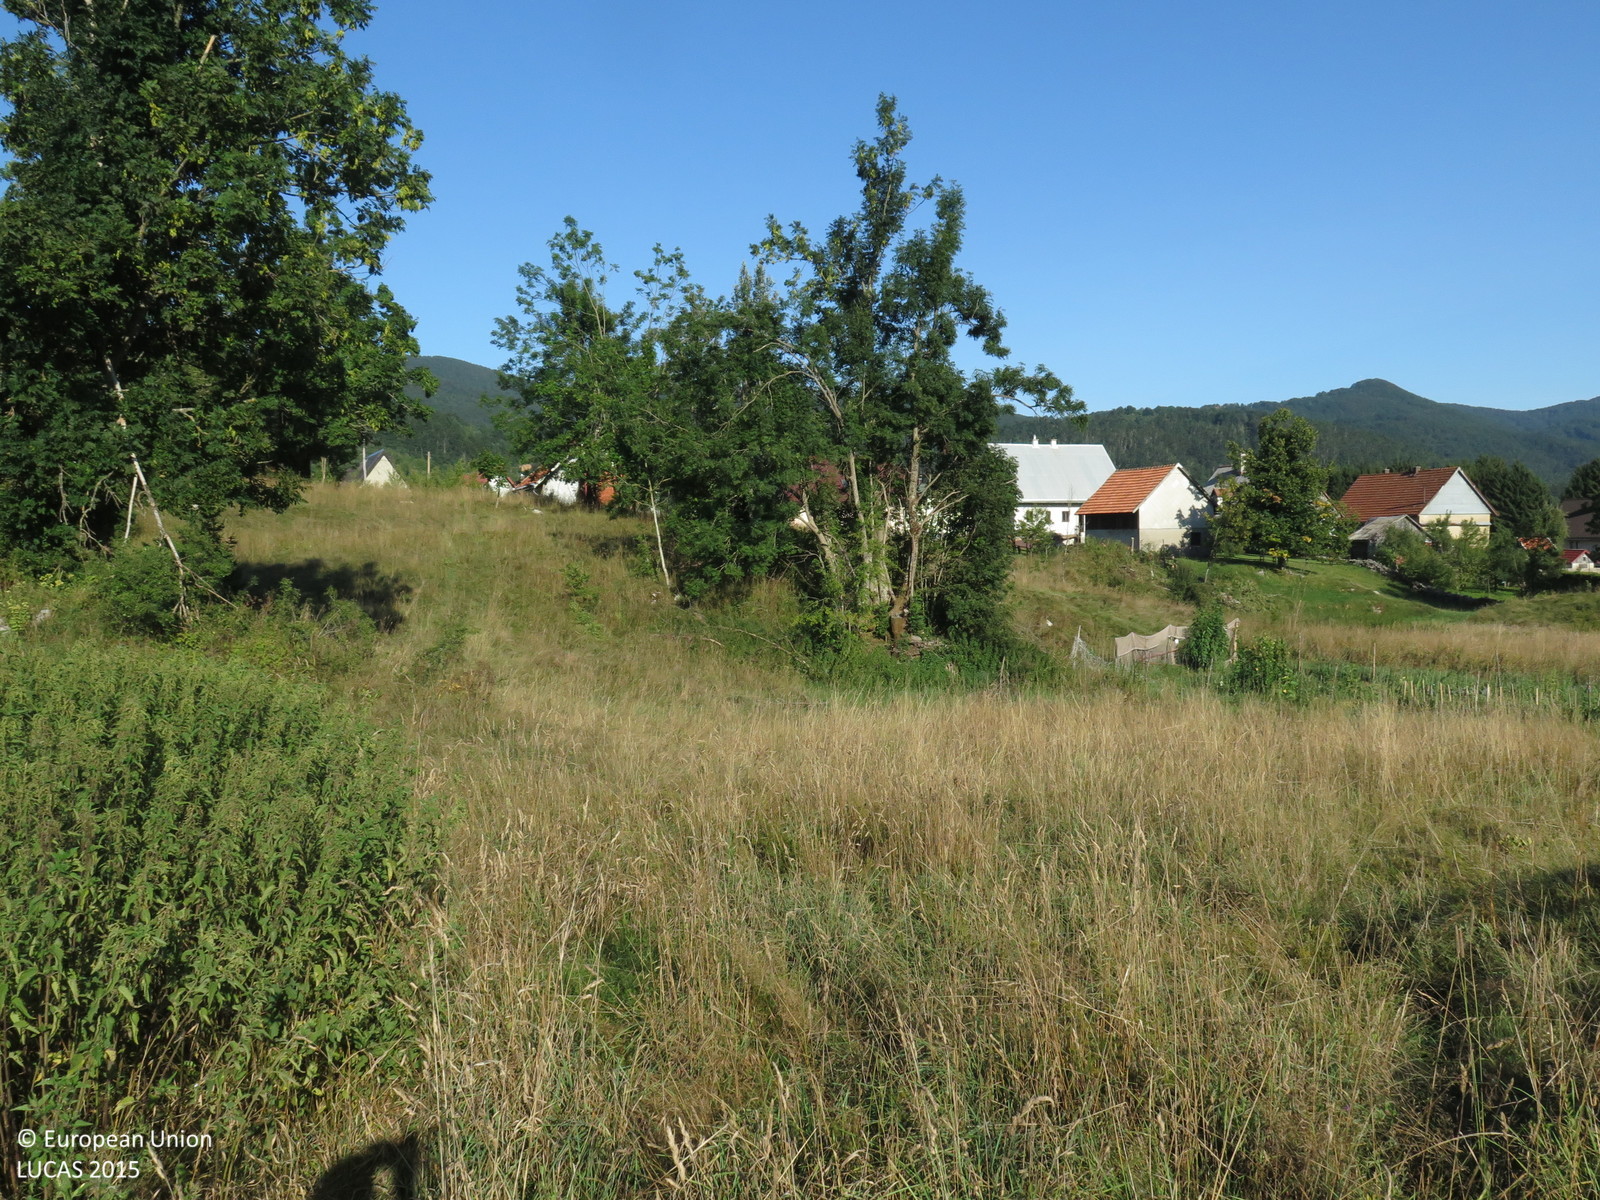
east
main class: Grassland
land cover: Grassland without tree/shrub cover
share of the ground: > 75 %
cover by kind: herbaceous plants 95 %, shrubs 5 %
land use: Agriculture (excluding fallow land and kitchen gardens)
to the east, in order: Grassland without tree/shrub cover; Artificial constructions in urban areas; Grassland without tree/shrub cover; Artificial constructions in urban areas
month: August
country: HR
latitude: 45.3205
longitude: 14.8556
